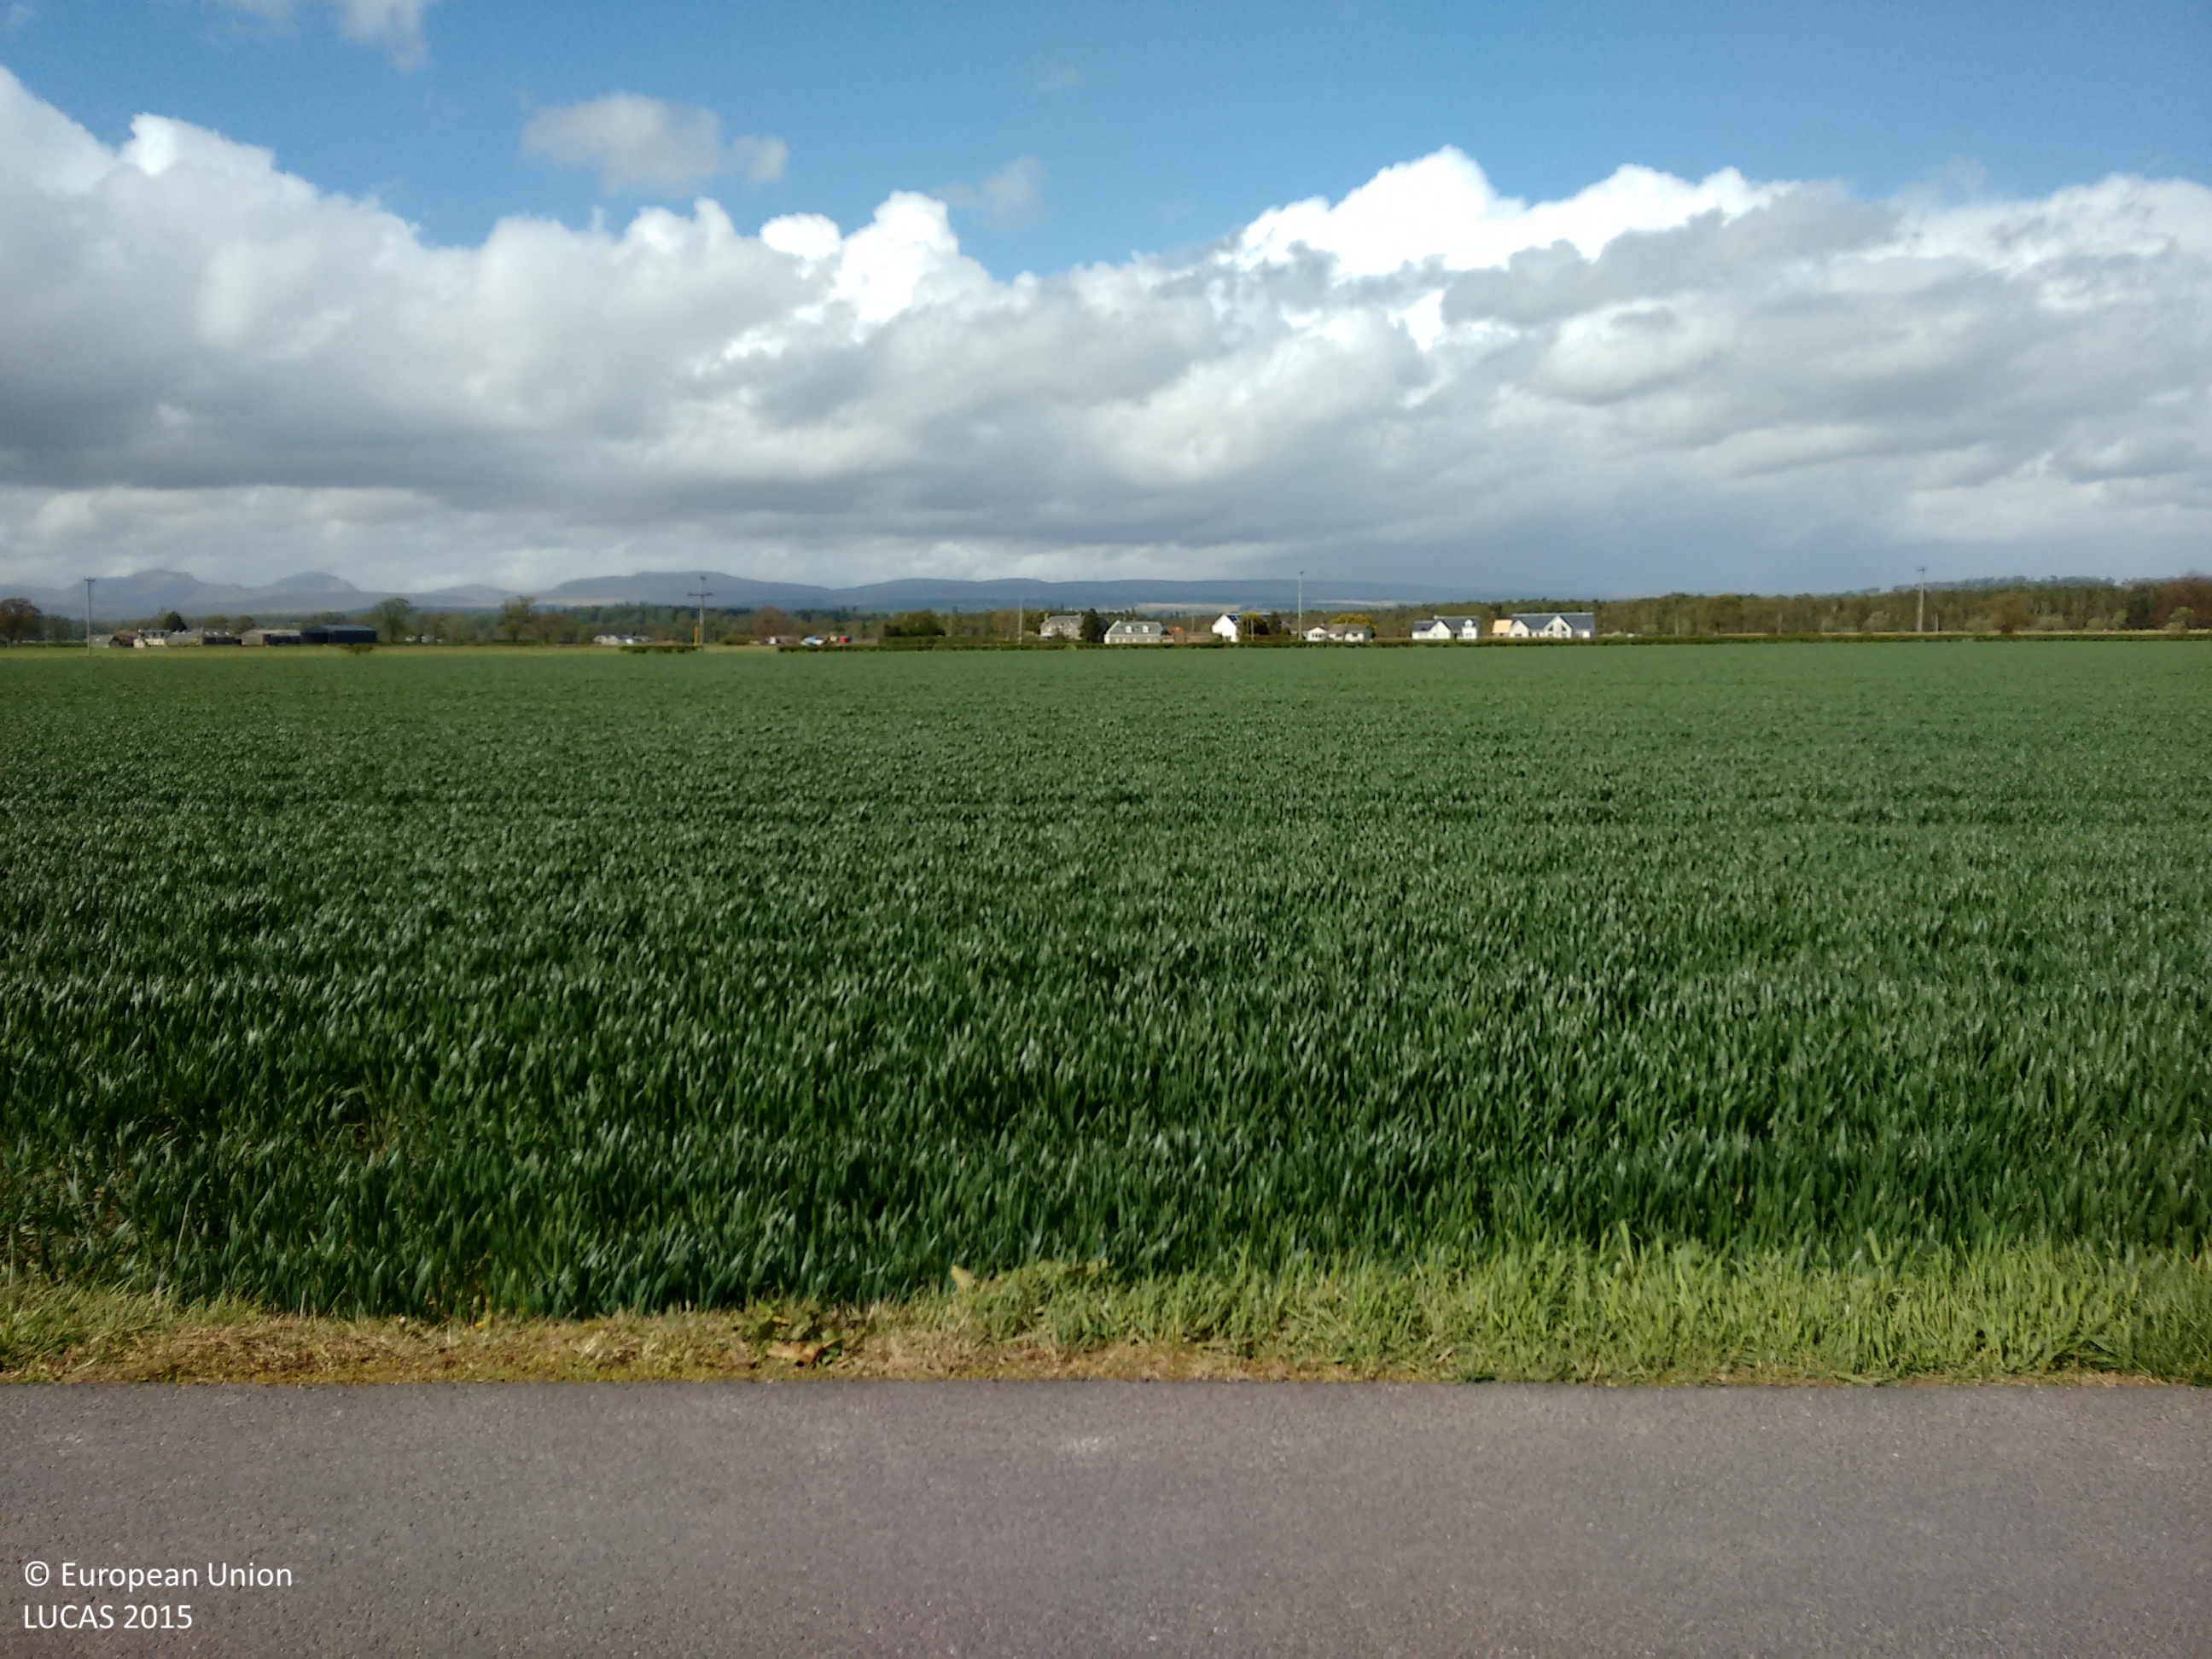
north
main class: Cropland
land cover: Barley
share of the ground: 10 - 25 %
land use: Agriculture (excluding fallow land and kitchen gardens)
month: May
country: GB
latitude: 56.1418
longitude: -4.0408
